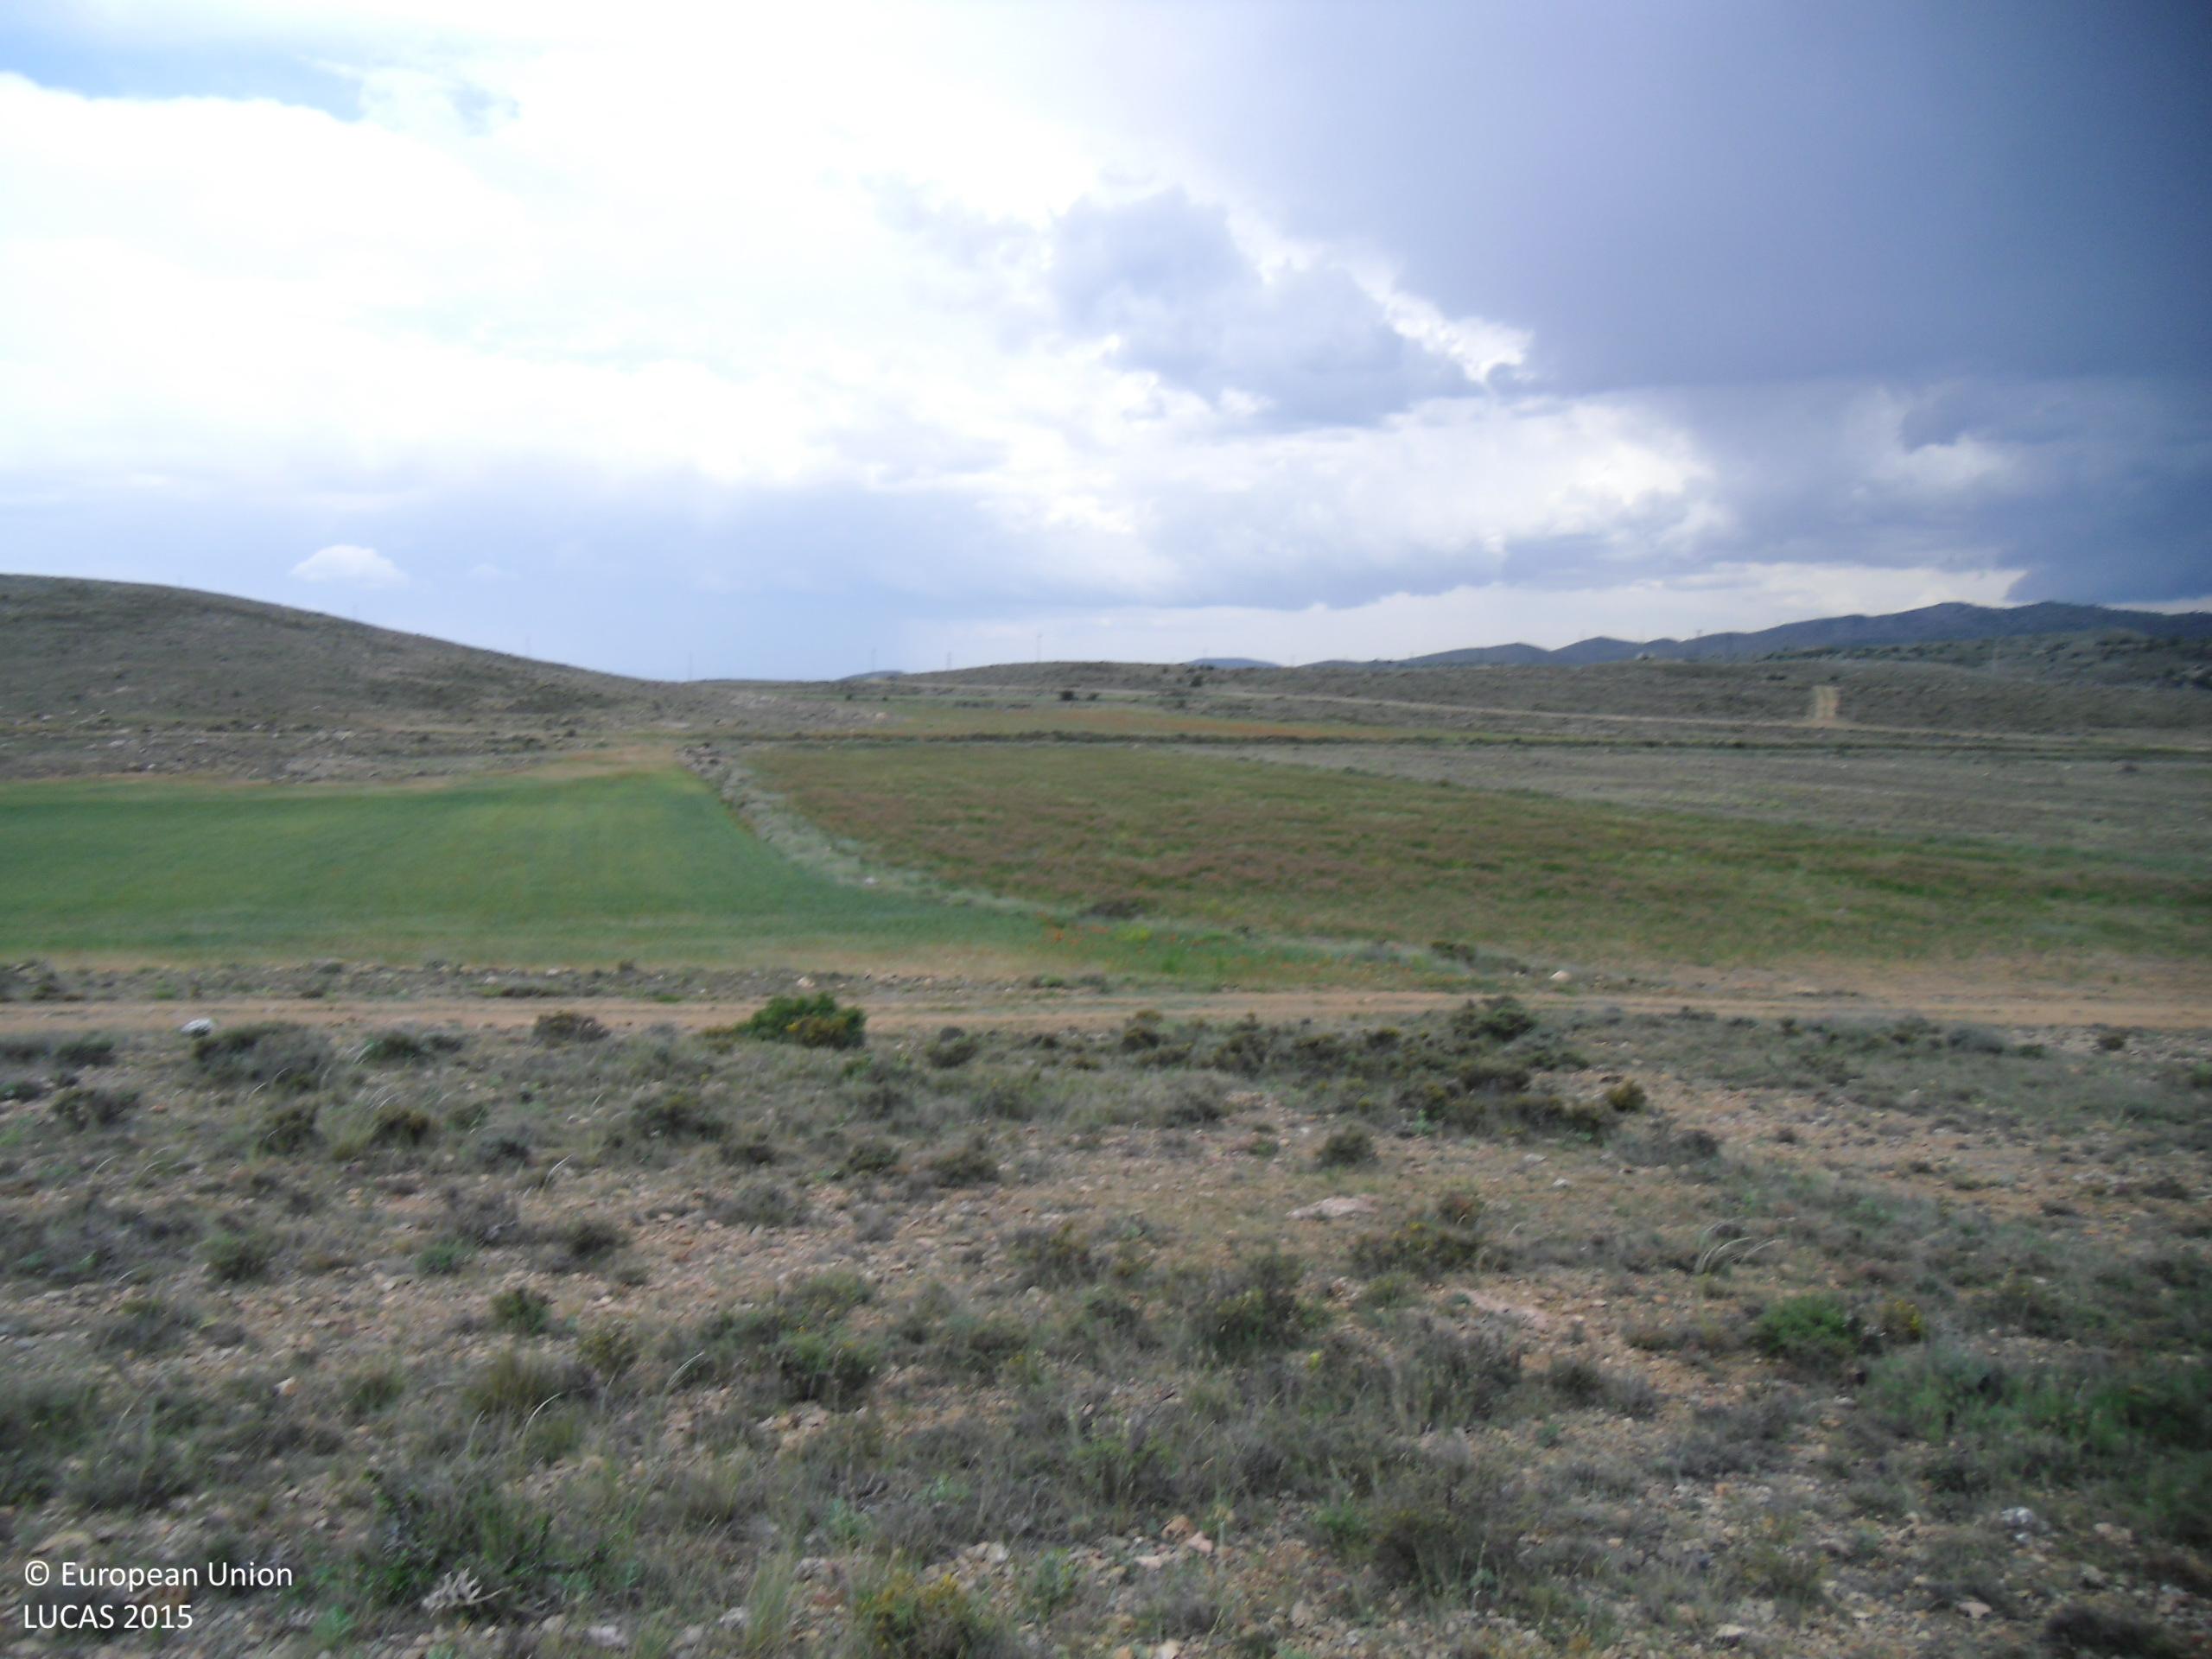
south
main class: Shrubland
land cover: Shrubland without tree cover
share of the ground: 10 - 25 %
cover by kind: consolidated bare surface 60 %, shrubs 20 %, herbaceous plants 20 %
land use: Agriculture (excluding fallow land and kitchen gardens)
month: May
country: ES
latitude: 40.9723
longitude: -0.8888
